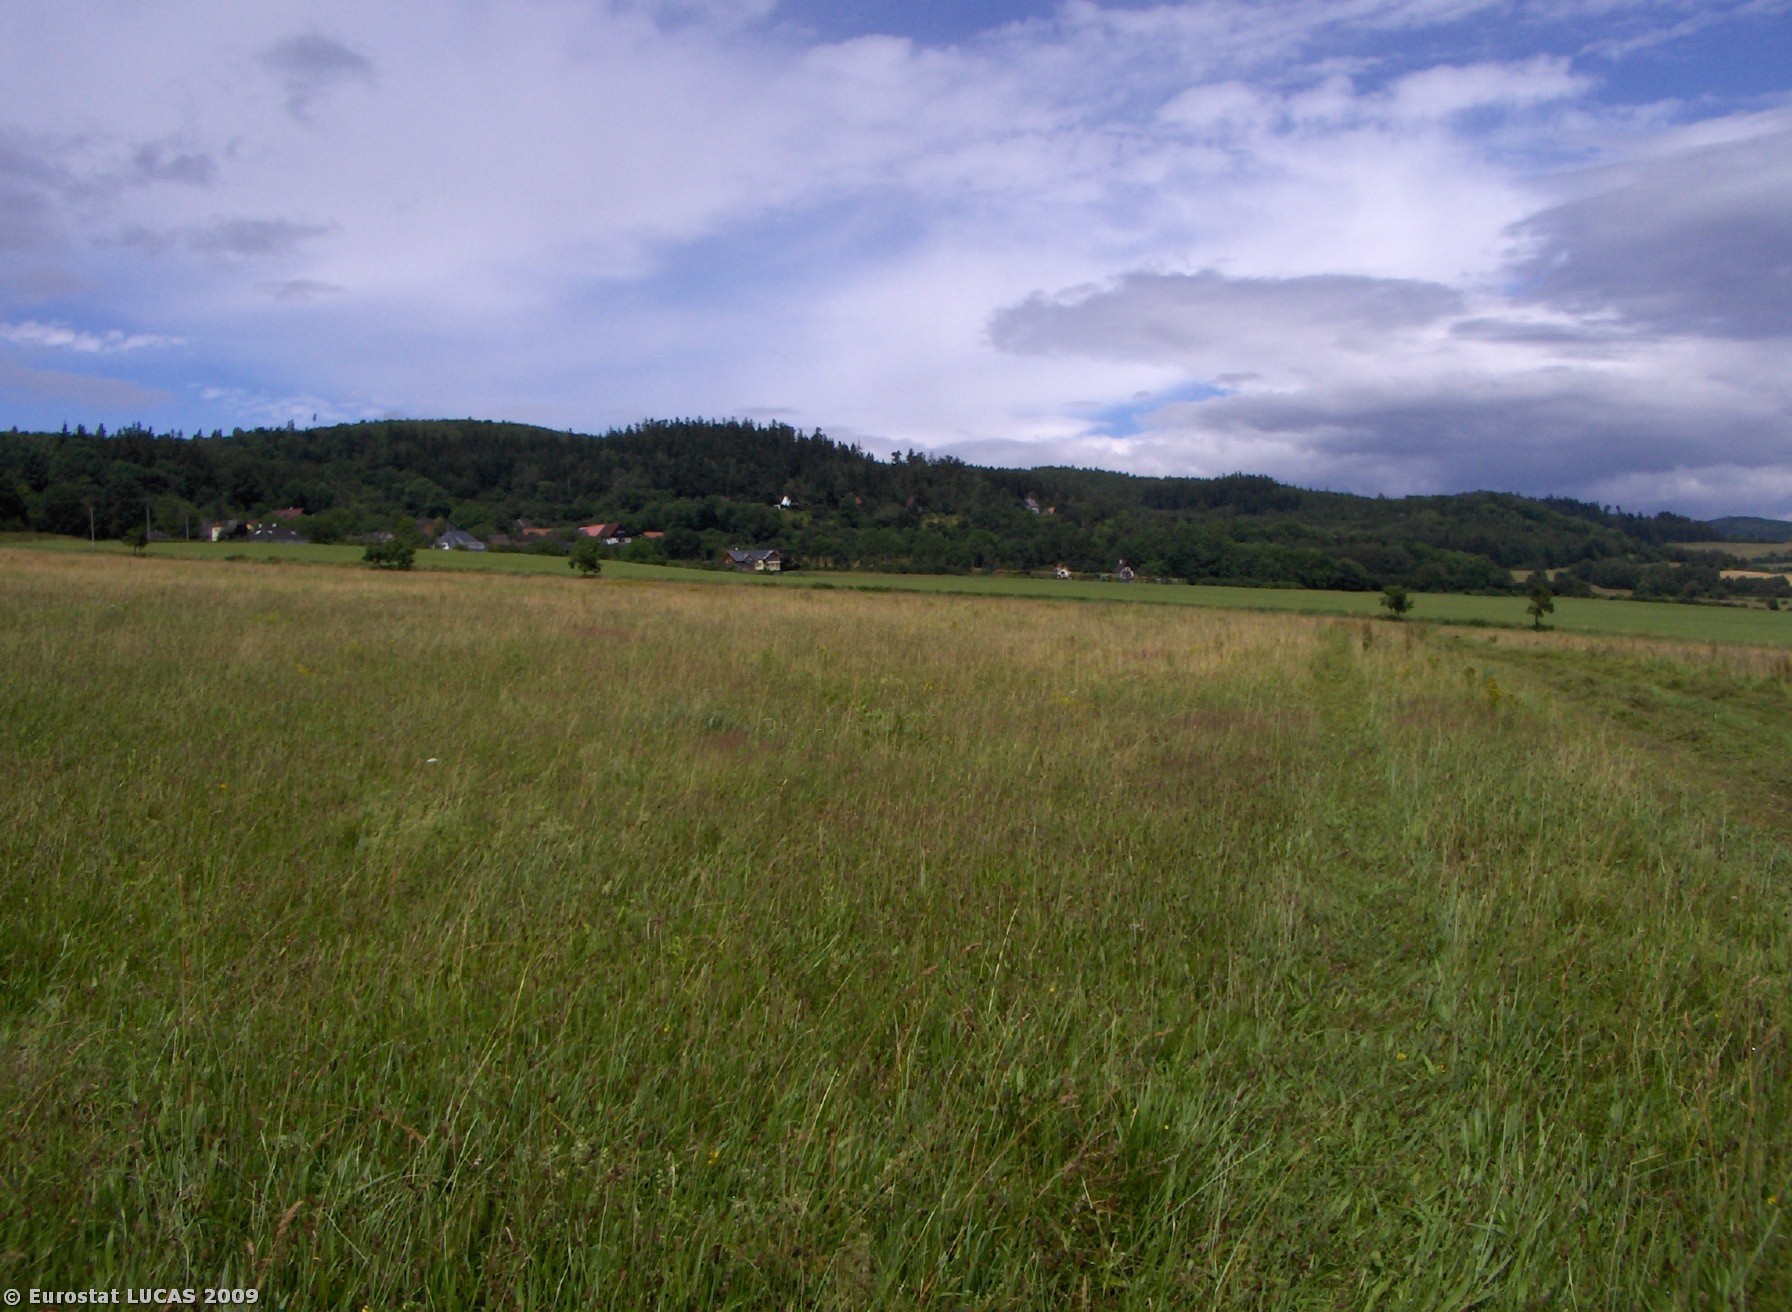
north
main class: Grassland
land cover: Grassland without tree/shrub cover
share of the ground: > 75 %
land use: Agriculture (excluding fallow land and kitchen gardens)
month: July
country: CZ
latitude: 49.3839
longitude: 13.1820
